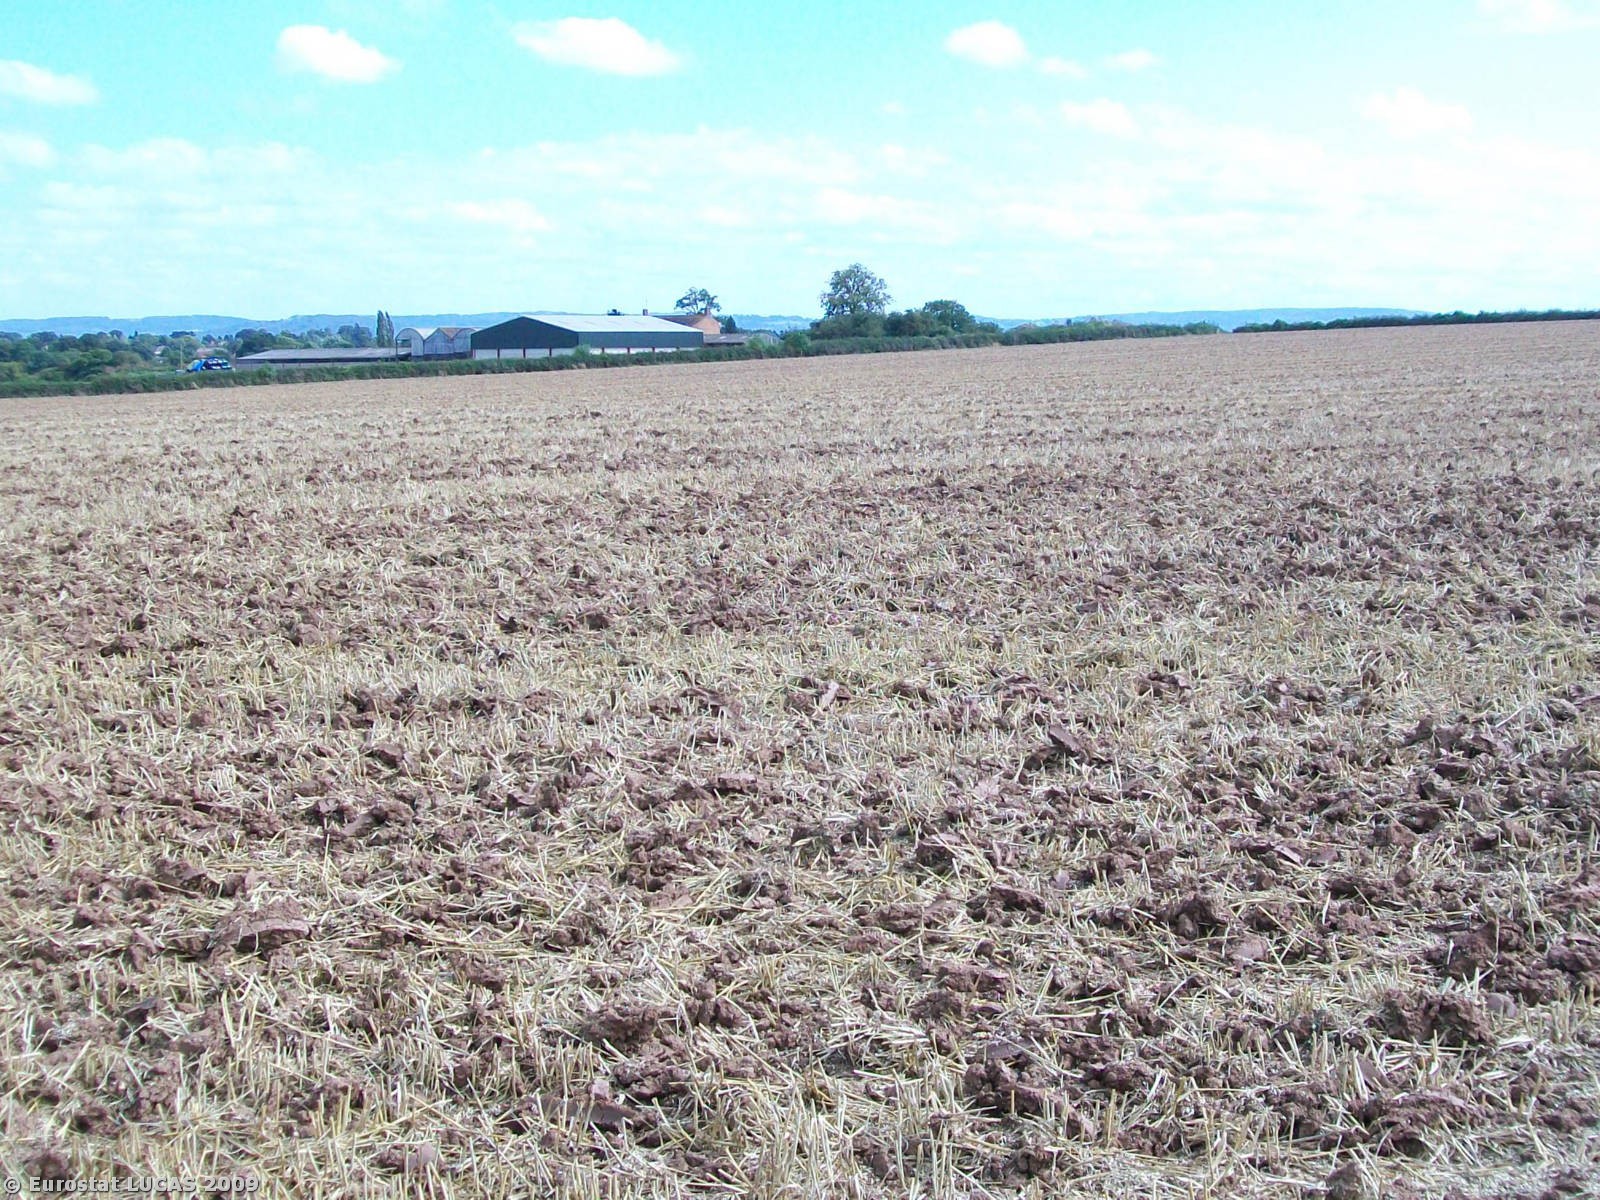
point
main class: Cropland
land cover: Common wheat
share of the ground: < 10 %
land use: Agriculture (excluding fallow land and kitchen gardens)
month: August
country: GB
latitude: 51.8733
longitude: -2.3667
